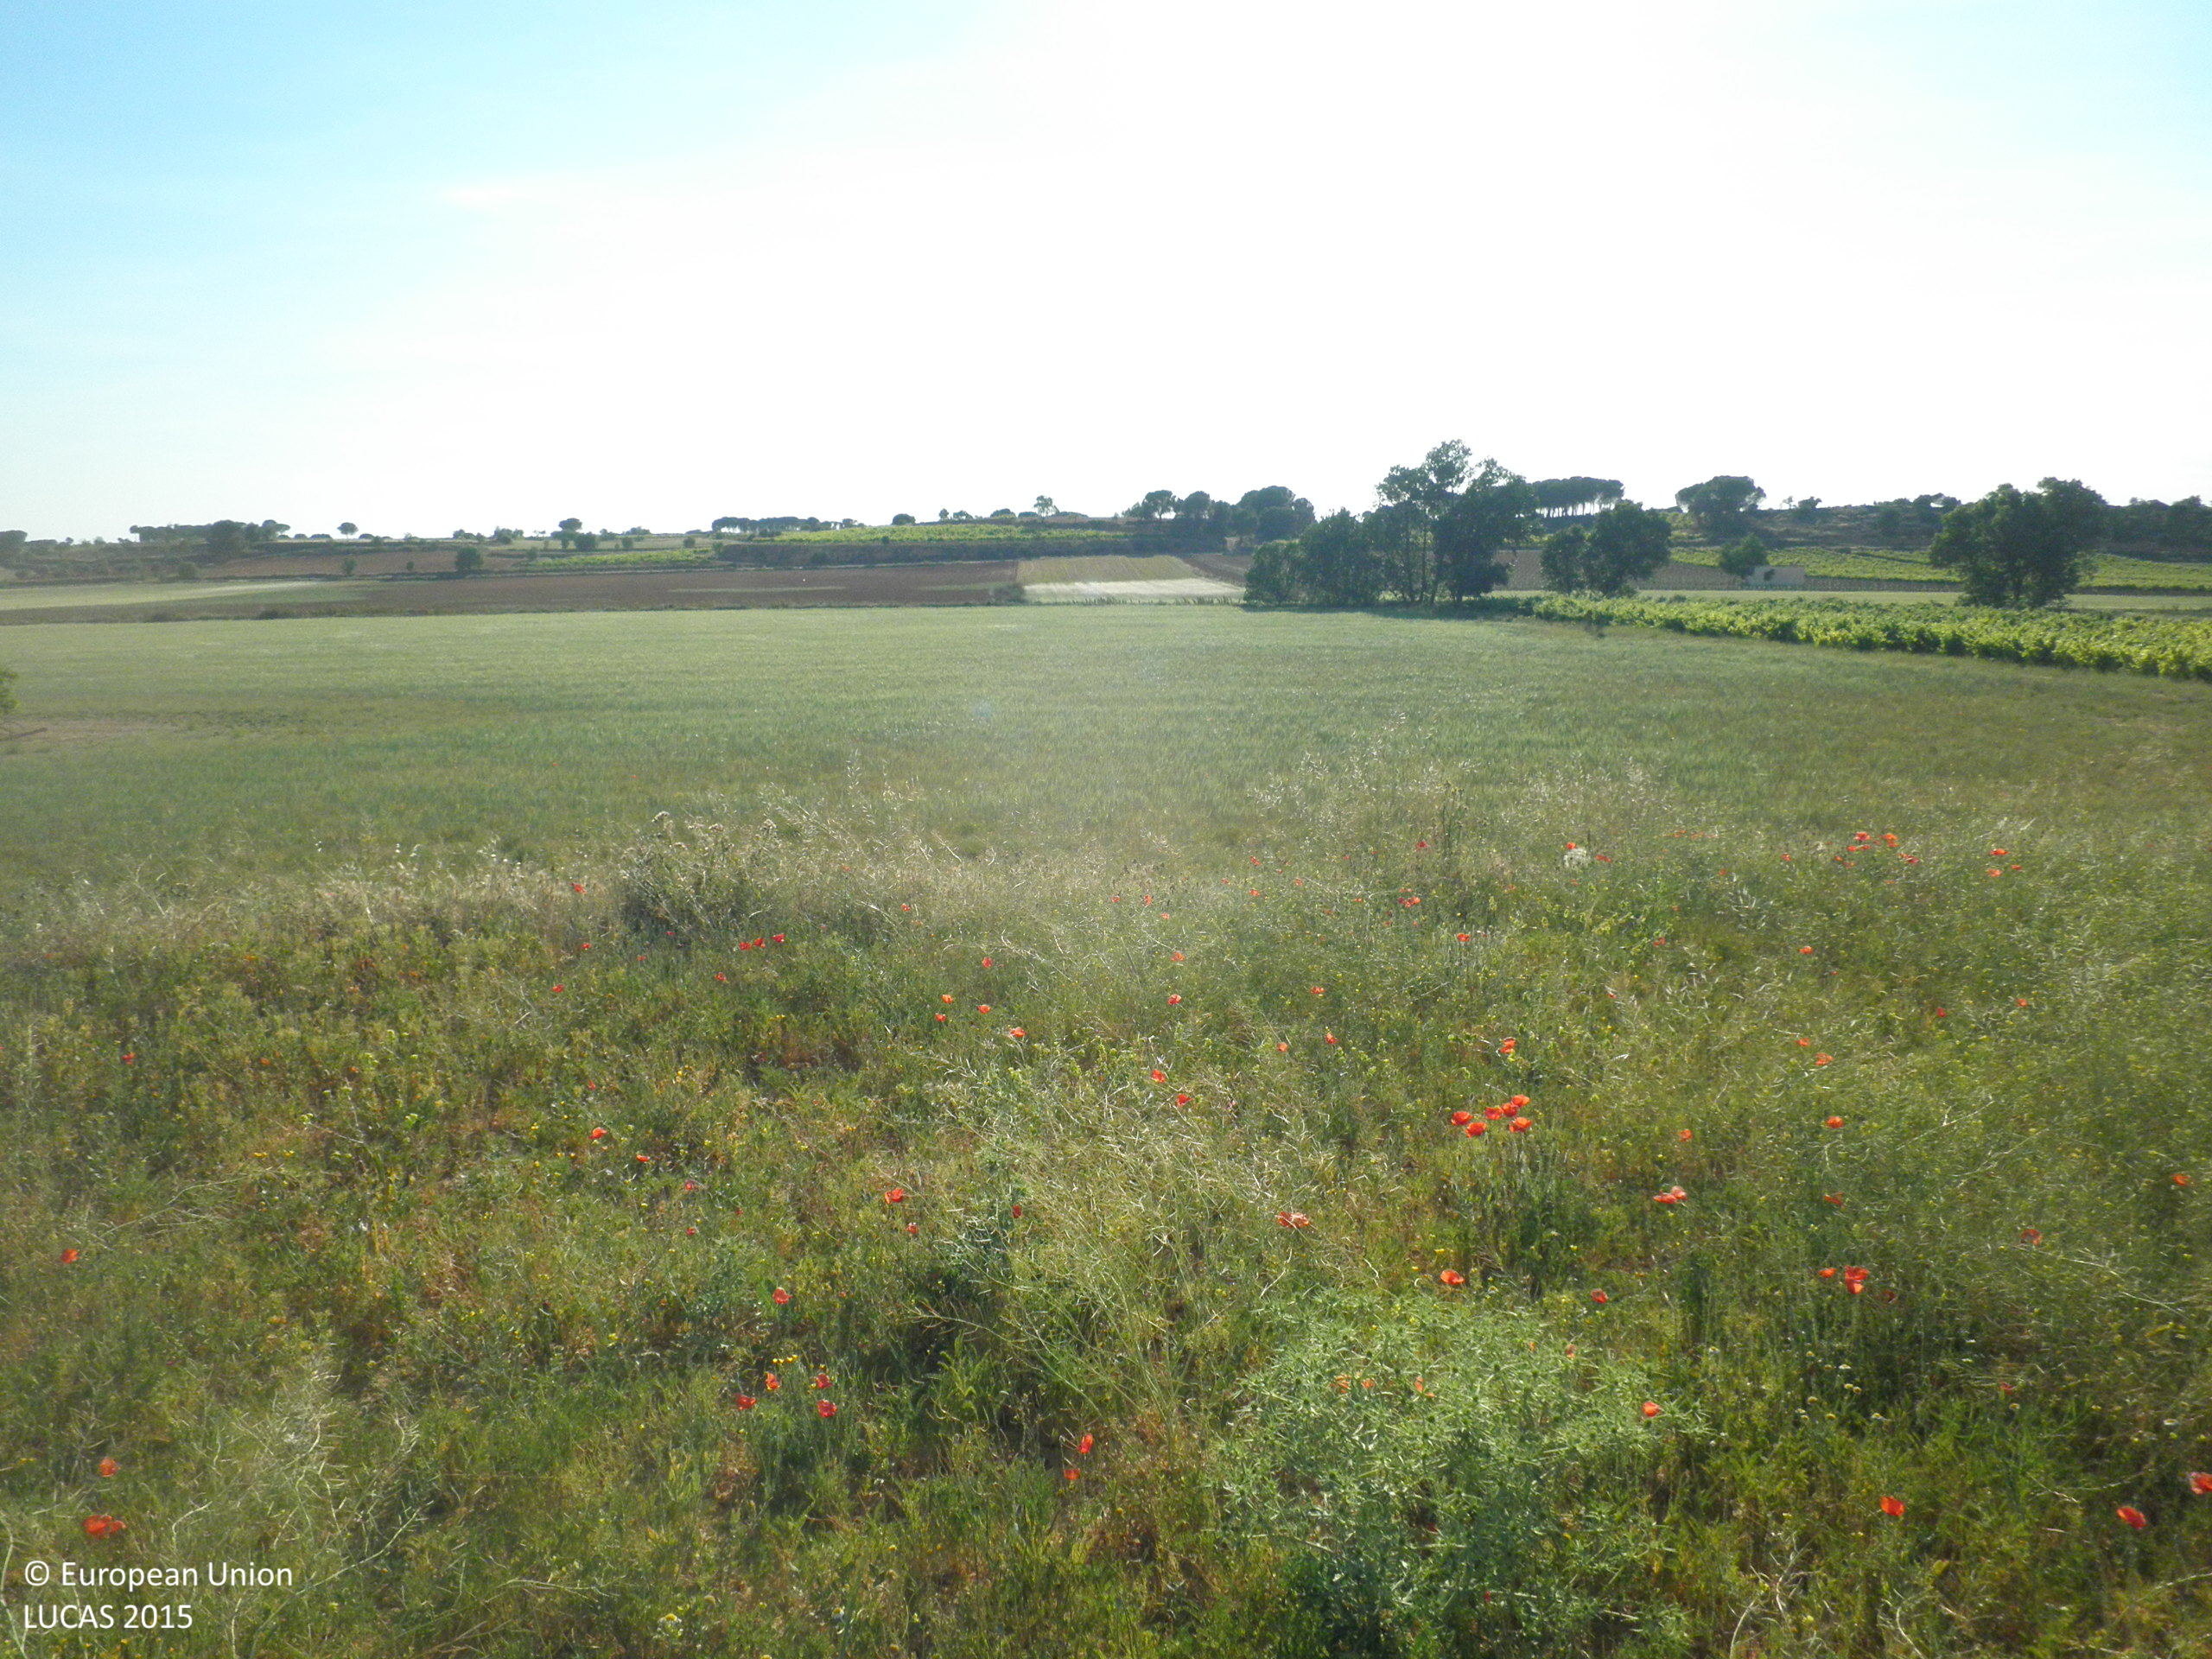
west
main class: Grassland
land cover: Spontaneously vegetated surfaces
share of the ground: > 75 %
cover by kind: herbaceous plants 75 %, unconsolidated bare surface 25 %
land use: Fallow land
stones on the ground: < 10 %
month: June
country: ES
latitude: 39.4129
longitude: -1.7470
